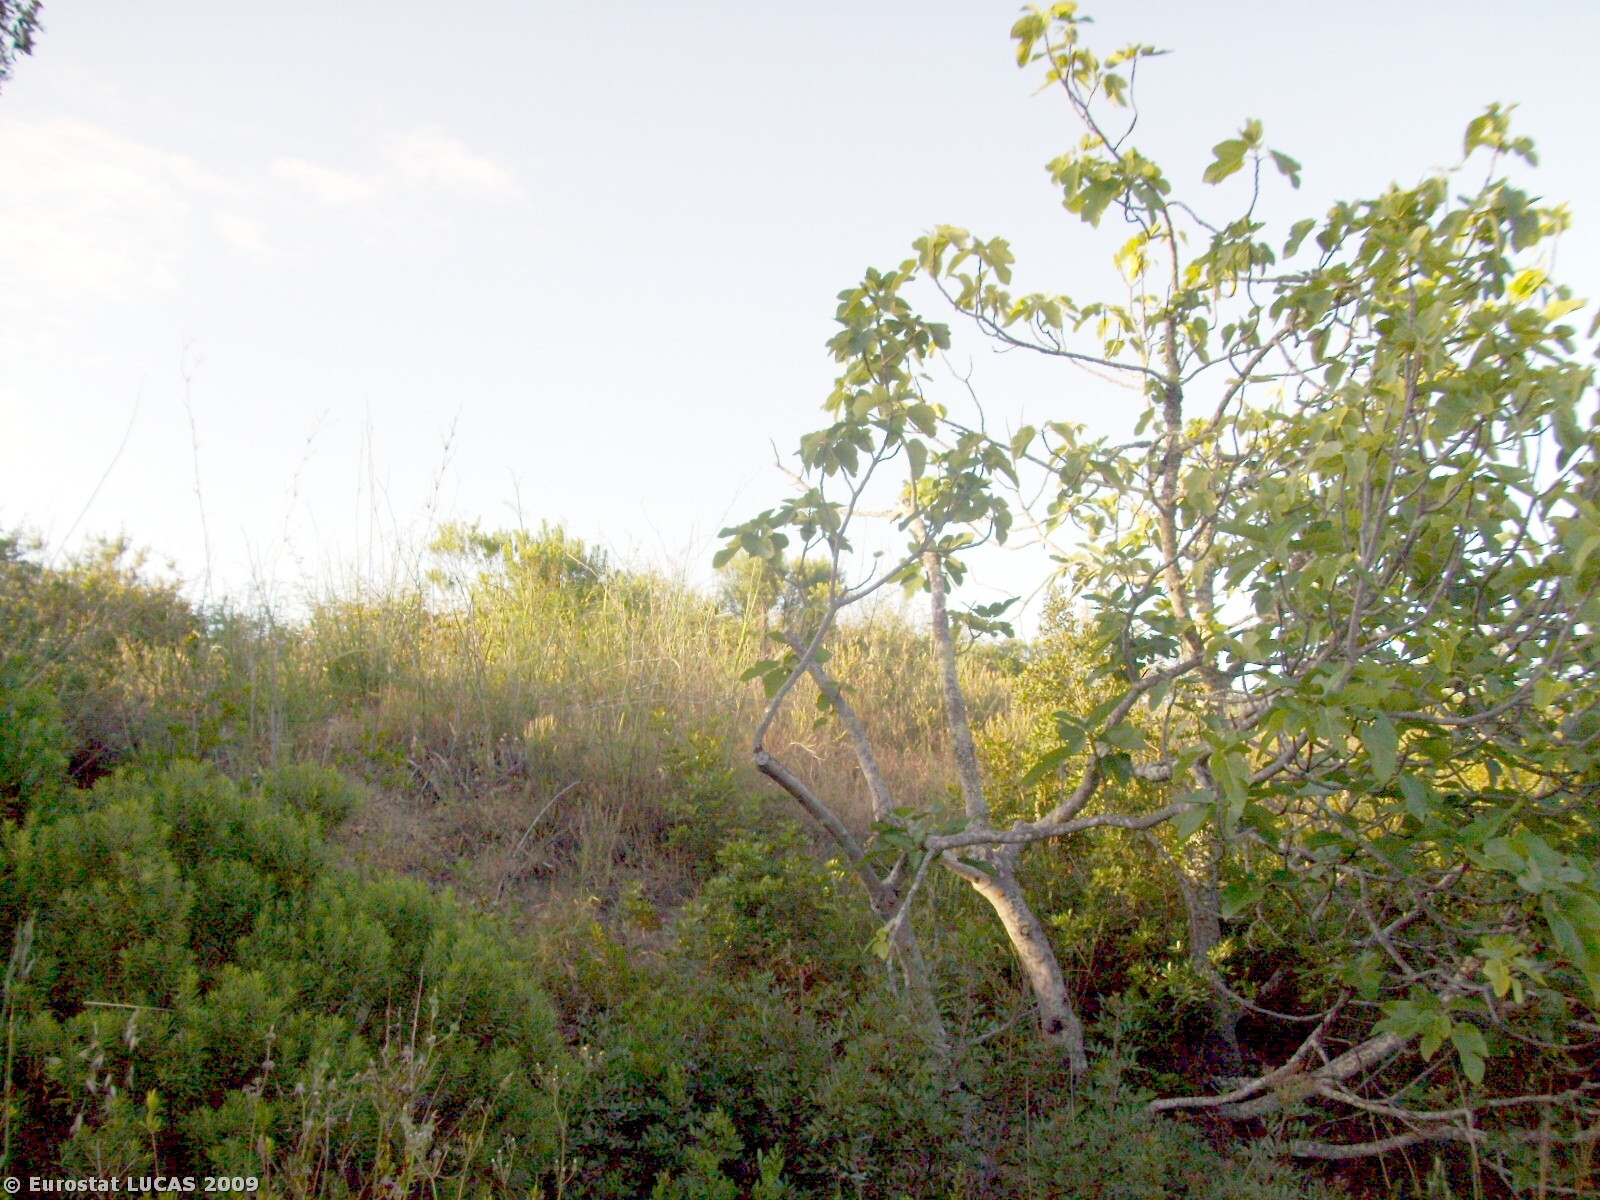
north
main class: Shrubland
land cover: Shrubland without tree cover
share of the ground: > 75 %
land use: Unused
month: May
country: PT
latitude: 37.2566
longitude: -8.1836
